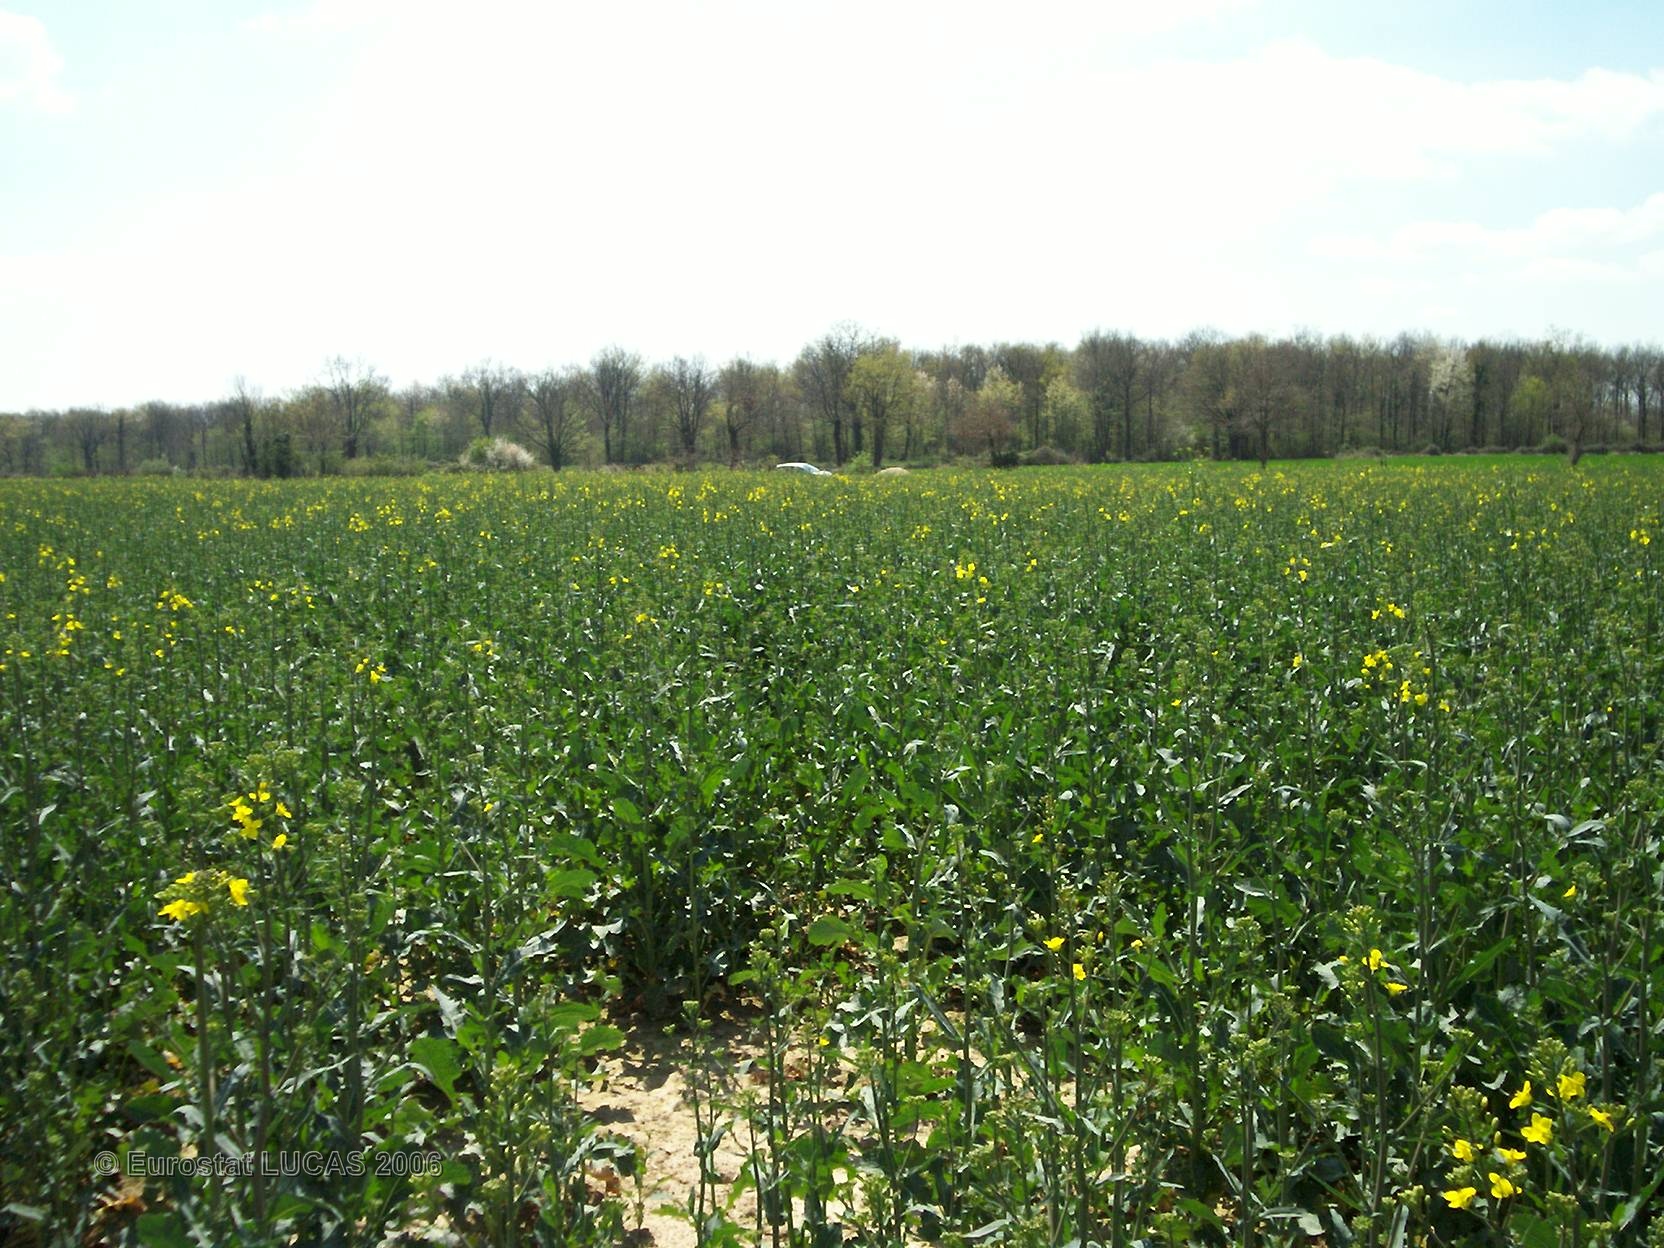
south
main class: Cropland
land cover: Rape and turnip rape
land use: Agriculture (excluding fallow land and kitchen gardens)
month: April
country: FR
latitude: 46.7066
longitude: 1.5791
